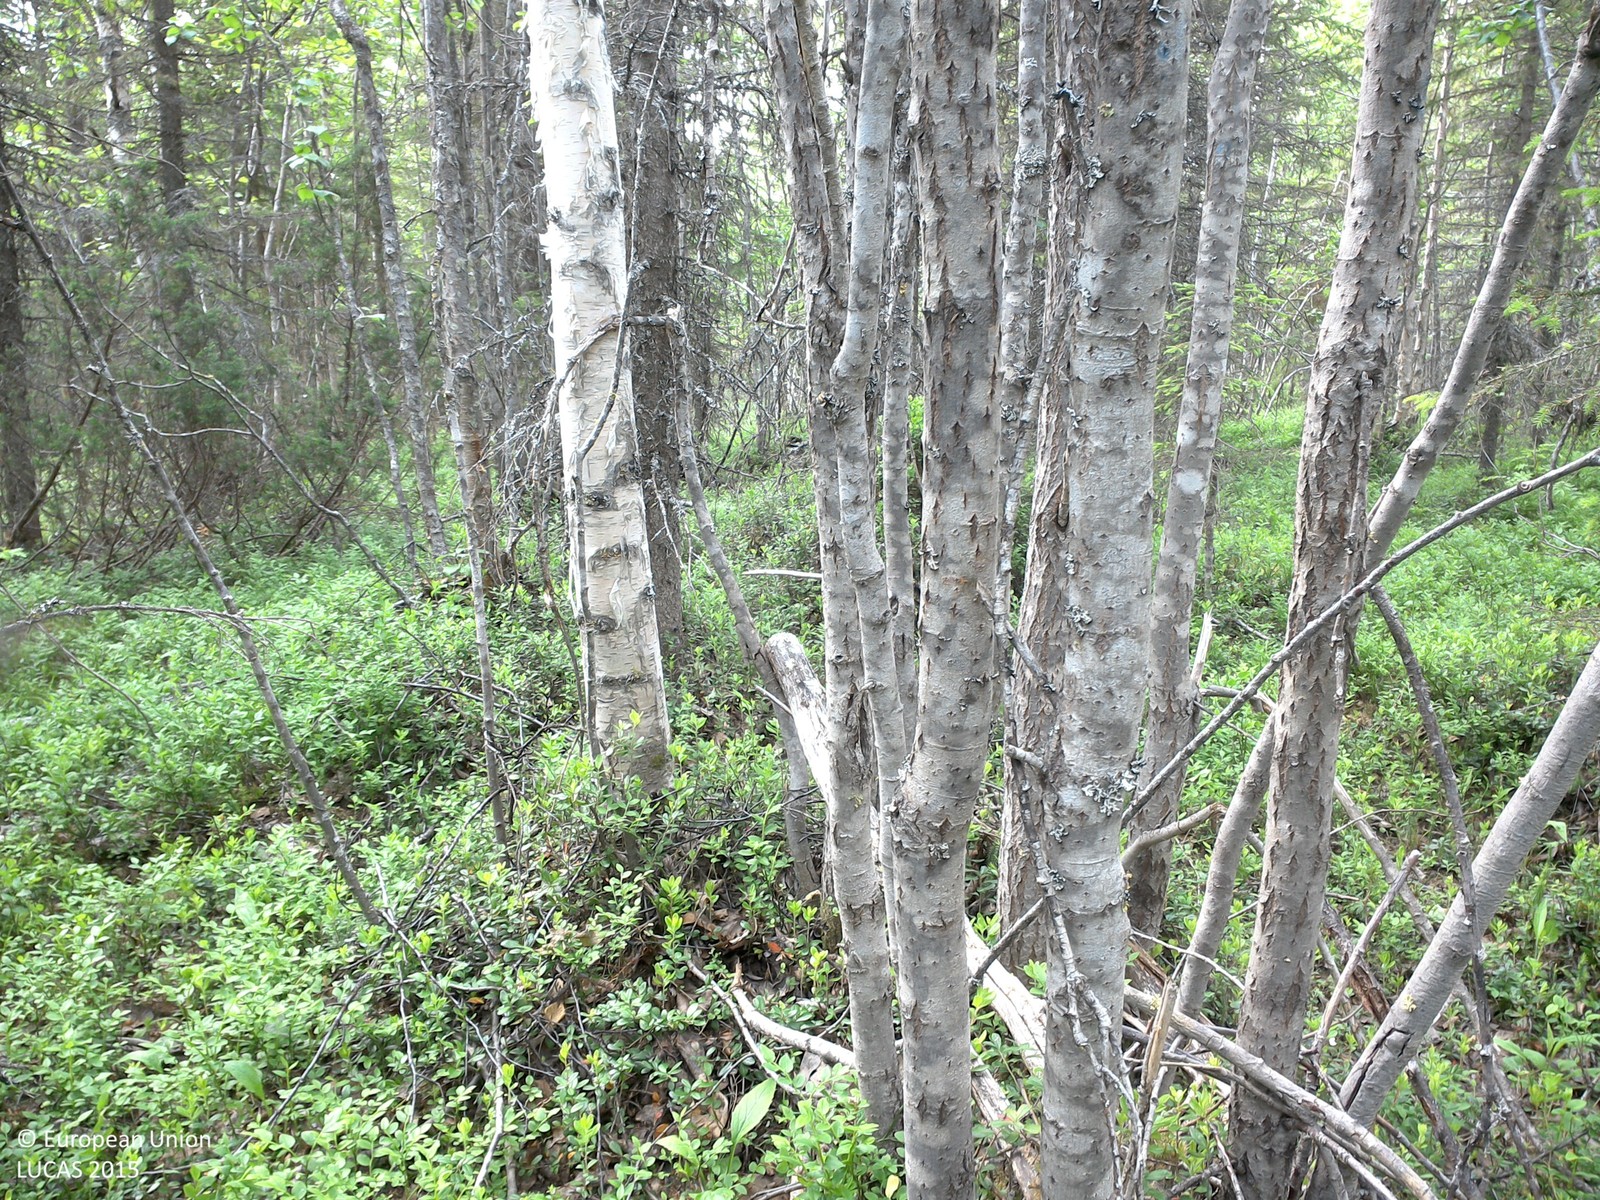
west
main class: Woodland
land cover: Spruce dominated mixed woodland
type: boreal forest
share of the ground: 10 - 25 %
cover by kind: shrubs 55 %, coniferous forest trees 30 %, broadleaved forest trees 15 %
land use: Forestry
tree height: > 5 m
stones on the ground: < 10 %
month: July
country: SE
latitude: 66.8483
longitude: 23.5874
